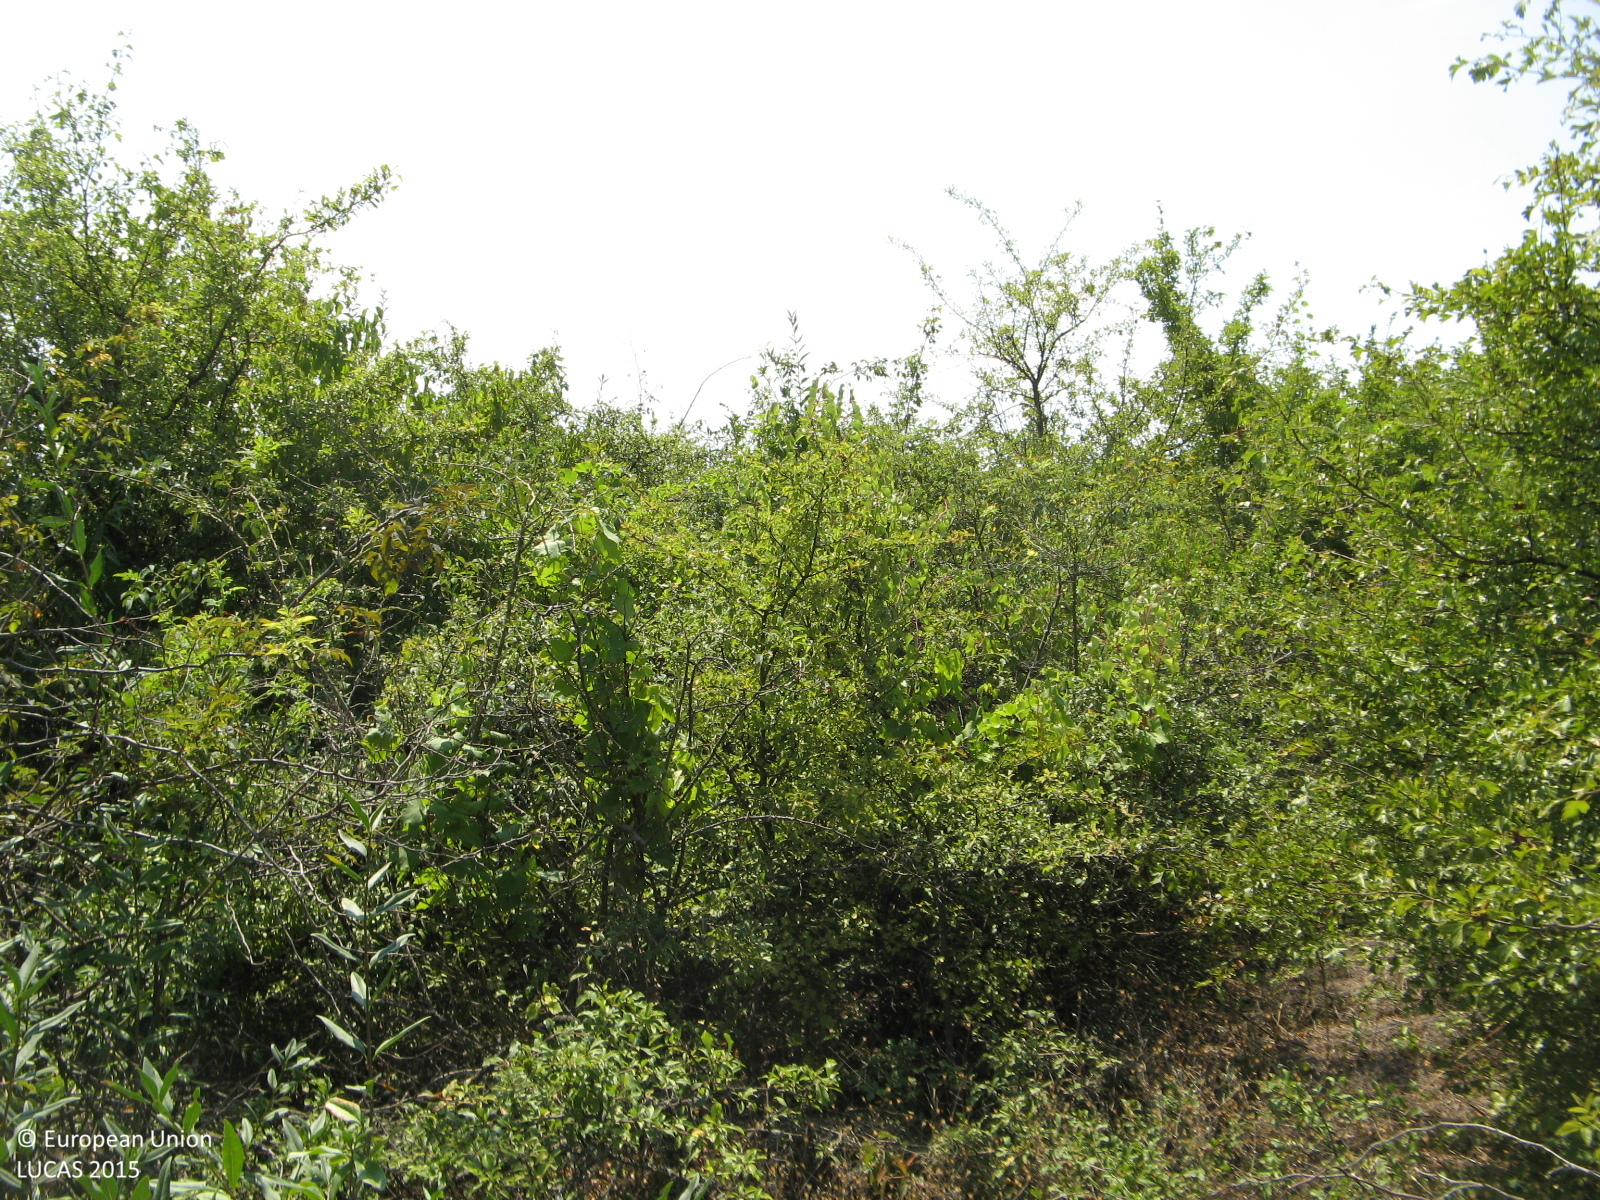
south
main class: Shrubland
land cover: Shrubland with sparse tree cover
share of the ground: > 75 %
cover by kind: shrubs 90 %, broadleaved forest trees 5 %, herbaceous plants 5 %
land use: Abandoned areas
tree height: < 5 m
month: August
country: BG
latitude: 43.3739
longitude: 25.2933
